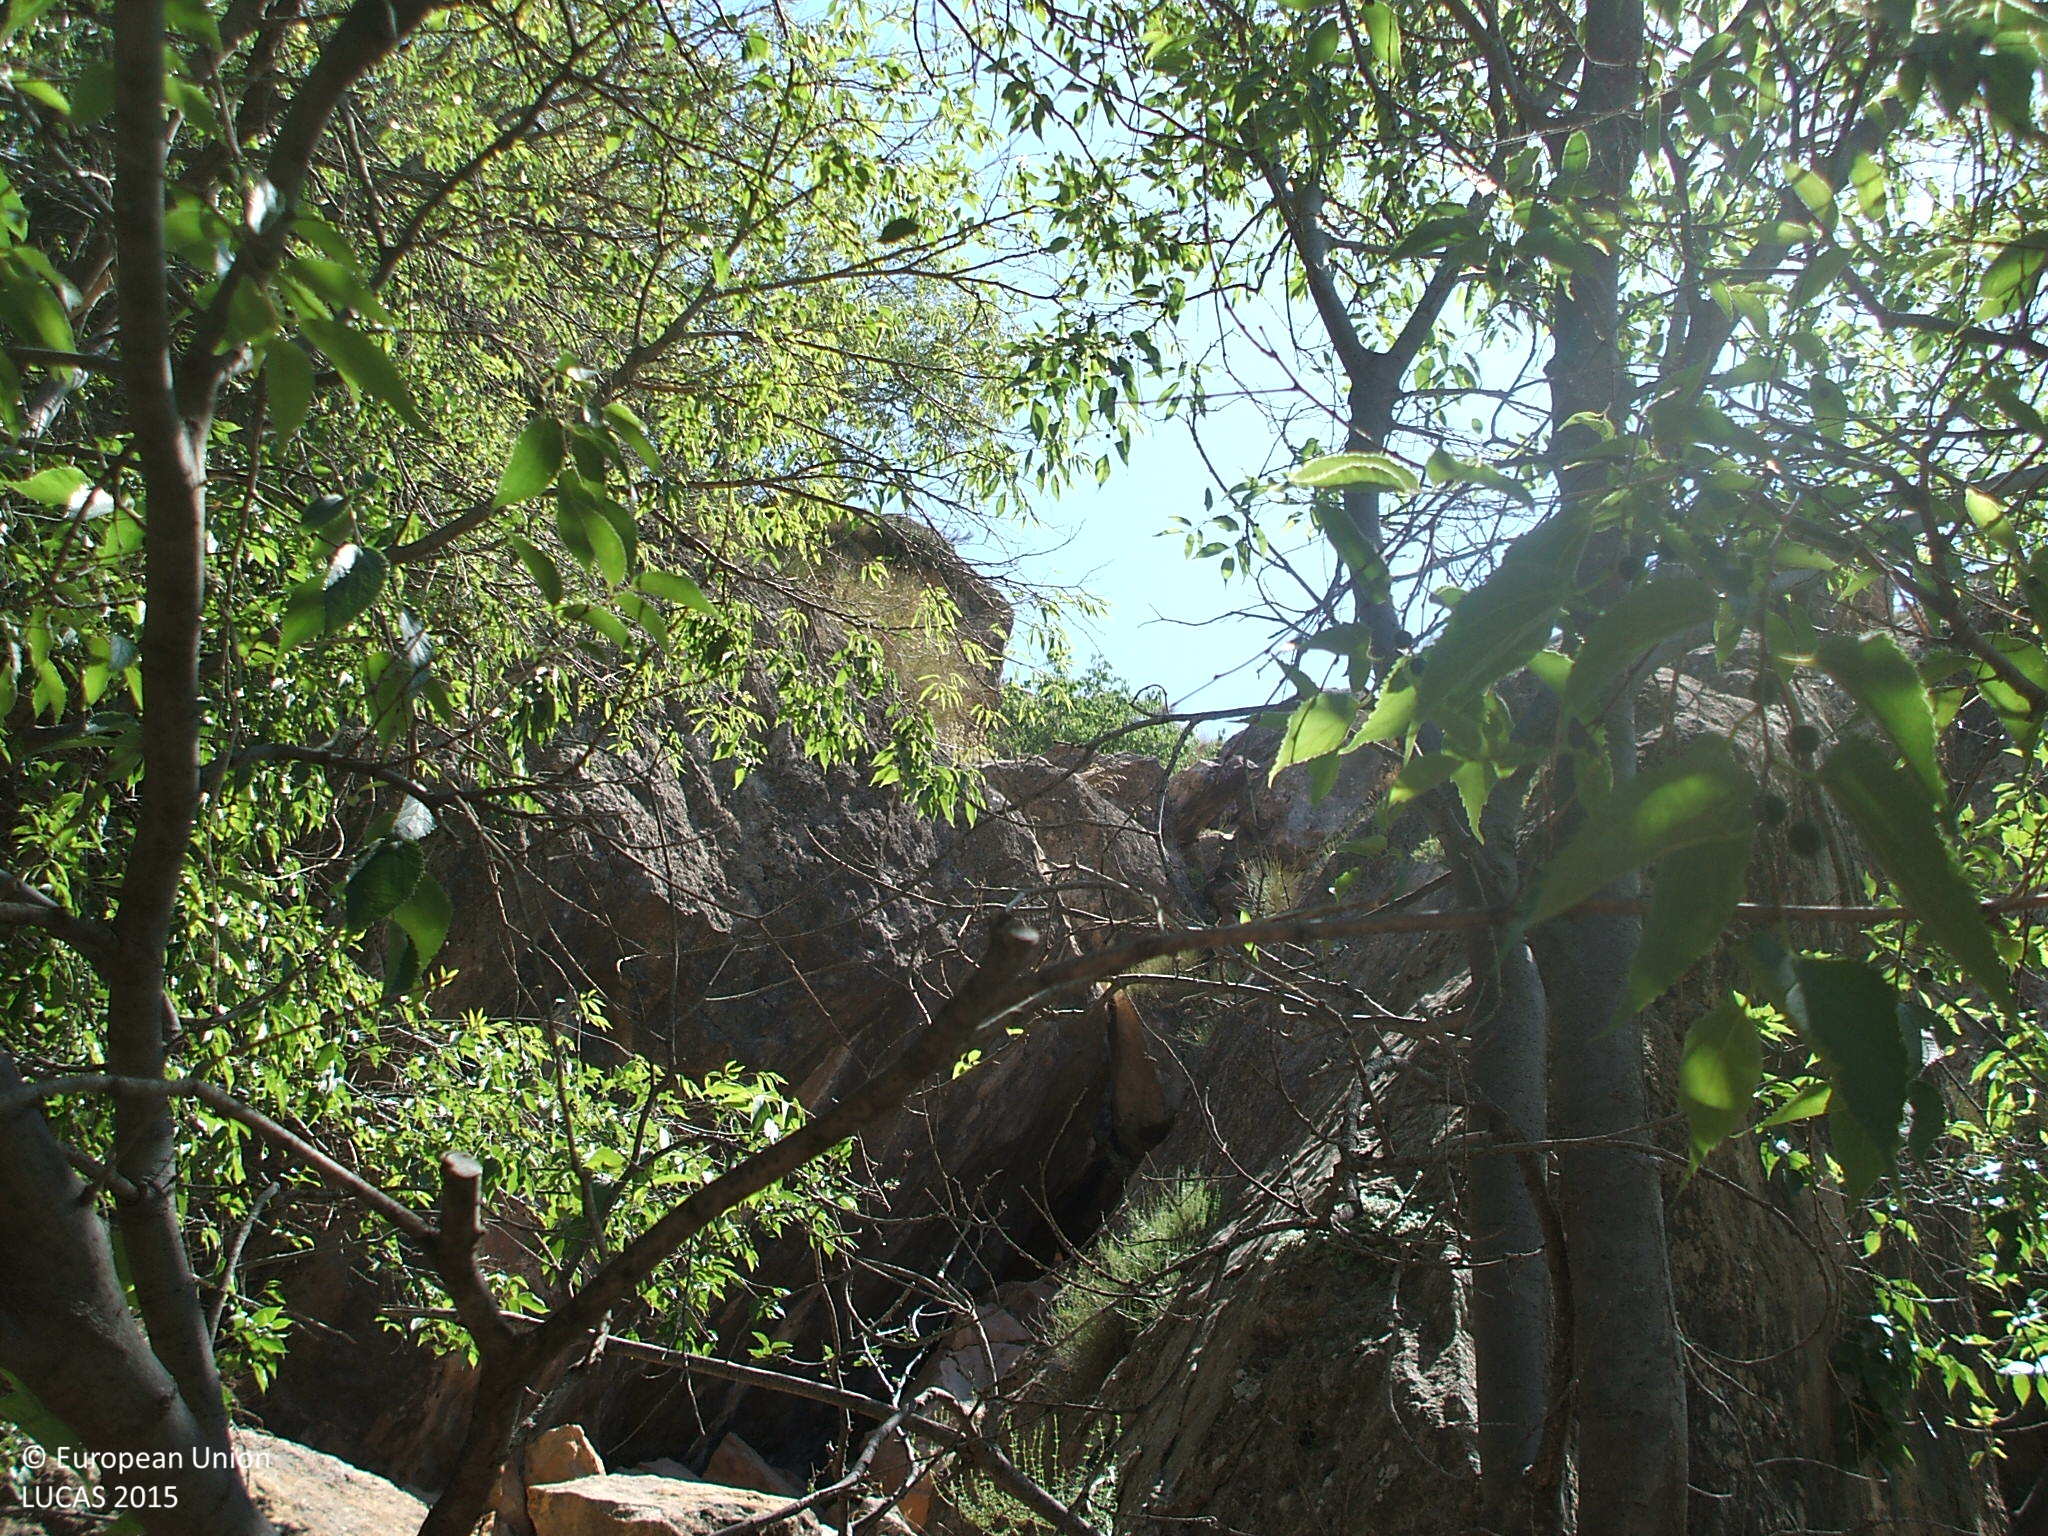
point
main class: Shrubland
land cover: Shrubland without tree cover
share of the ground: 50 - 75 %
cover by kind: shrubs 70 %, consolidated bare surface 30 %
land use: Semi-natural and natural areas not in use
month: June
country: ES
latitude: 37.0067
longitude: -2.8025
